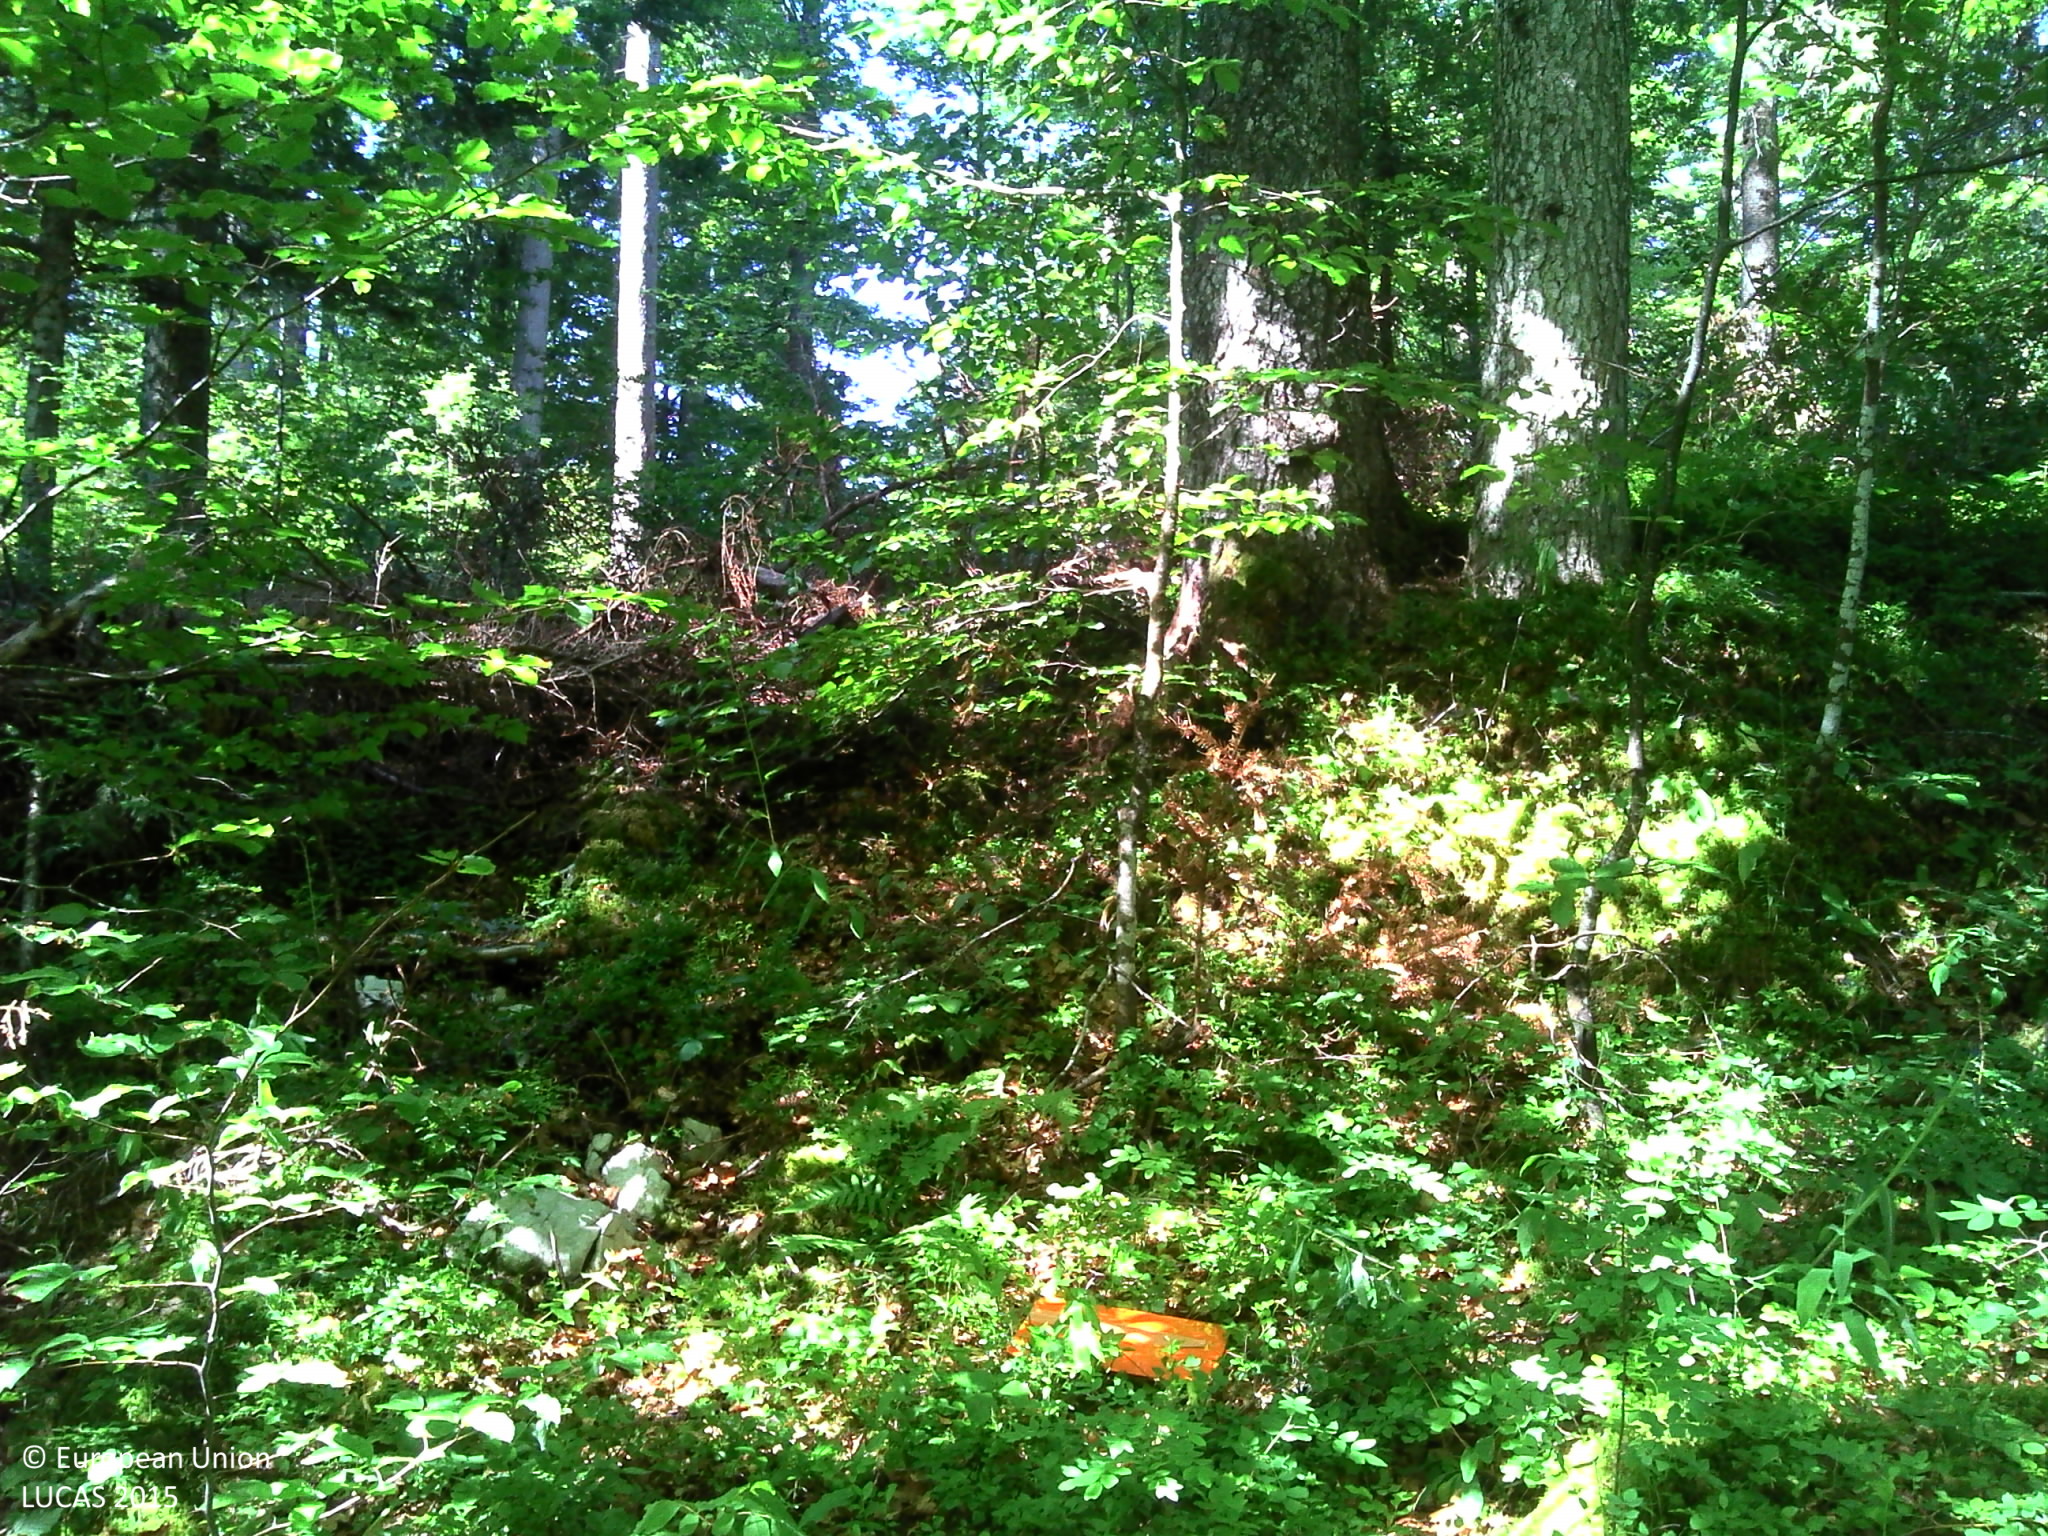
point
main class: Woodland
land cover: Spruce dominated mixed woodland
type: mountainous beech forest
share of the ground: > 75 %
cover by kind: broadleaved forest trees 35 %, coniferous forest trees 30 %, consolidated bare surface 20 %, lichens and mosses 10 %, herbaceous plants 5 %
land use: Forestry
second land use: Sport
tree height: > 5 m
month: July
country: FR
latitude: 46.5687
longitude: 6.1019
